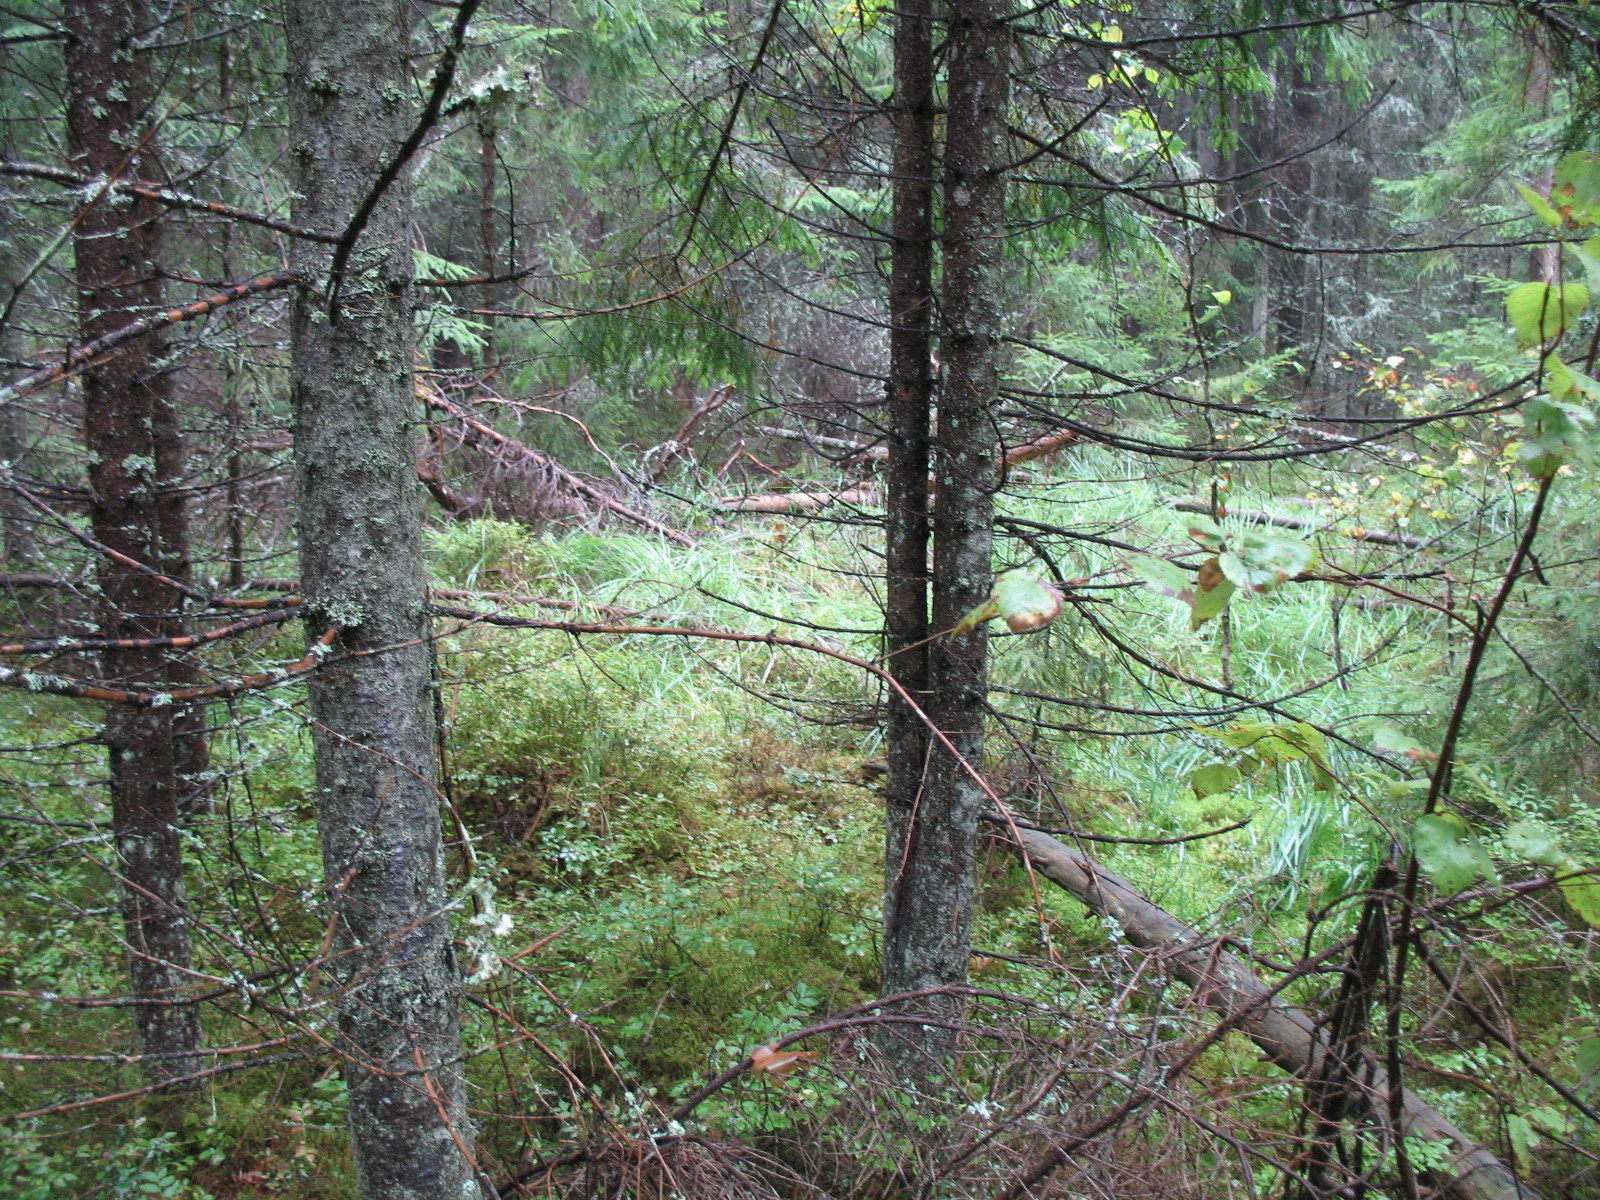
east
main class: Woodland
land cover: Other coniferous woodland
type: hemiboreal forest and nemoral coniferous forest and mixed broadleaved-coniferous forest
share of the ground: > 75 %
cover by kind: coniferous forest trees 75 %, herbaceous plants 10 %, lichens and mosses 10 %, shrubs 5 %
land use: Forestry
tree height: > 5 m
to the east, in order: Other coniferous woodland
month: September
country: LV
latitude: 56.1305
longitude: 26.2805
